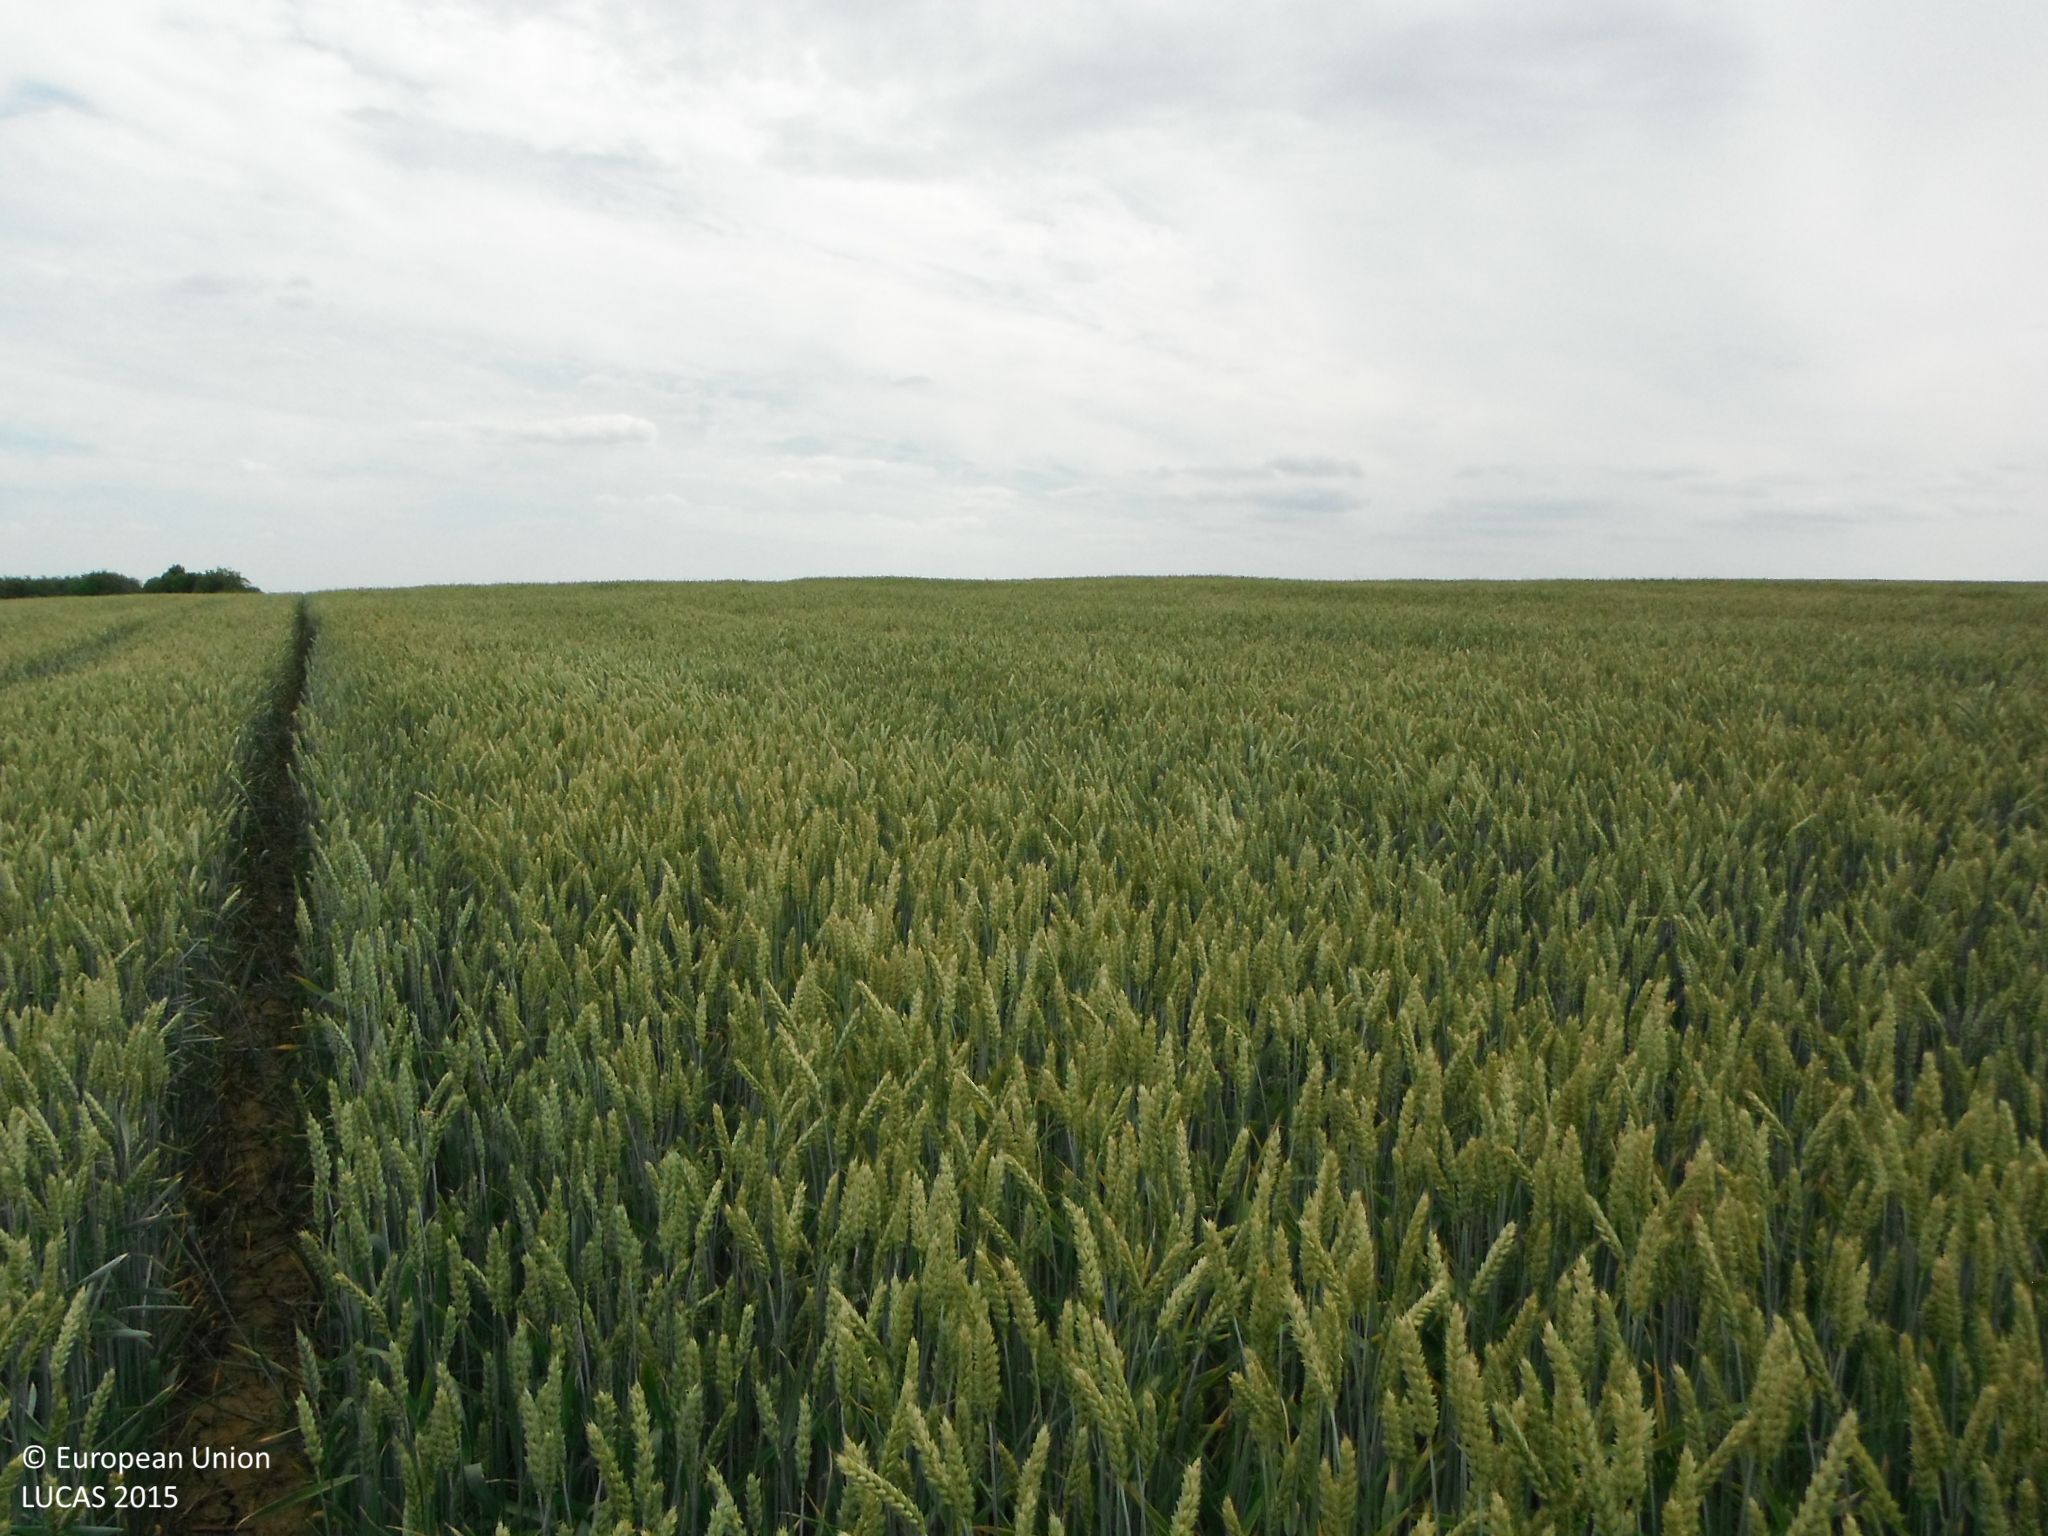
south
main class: Cropland
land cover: Common wheat
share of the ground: > 75 %
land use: Agriculture (excluding fallow land and kitchen gardens)
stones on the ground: < 10 %
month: June
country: SK
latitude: 48.3096
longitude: 18.2801
